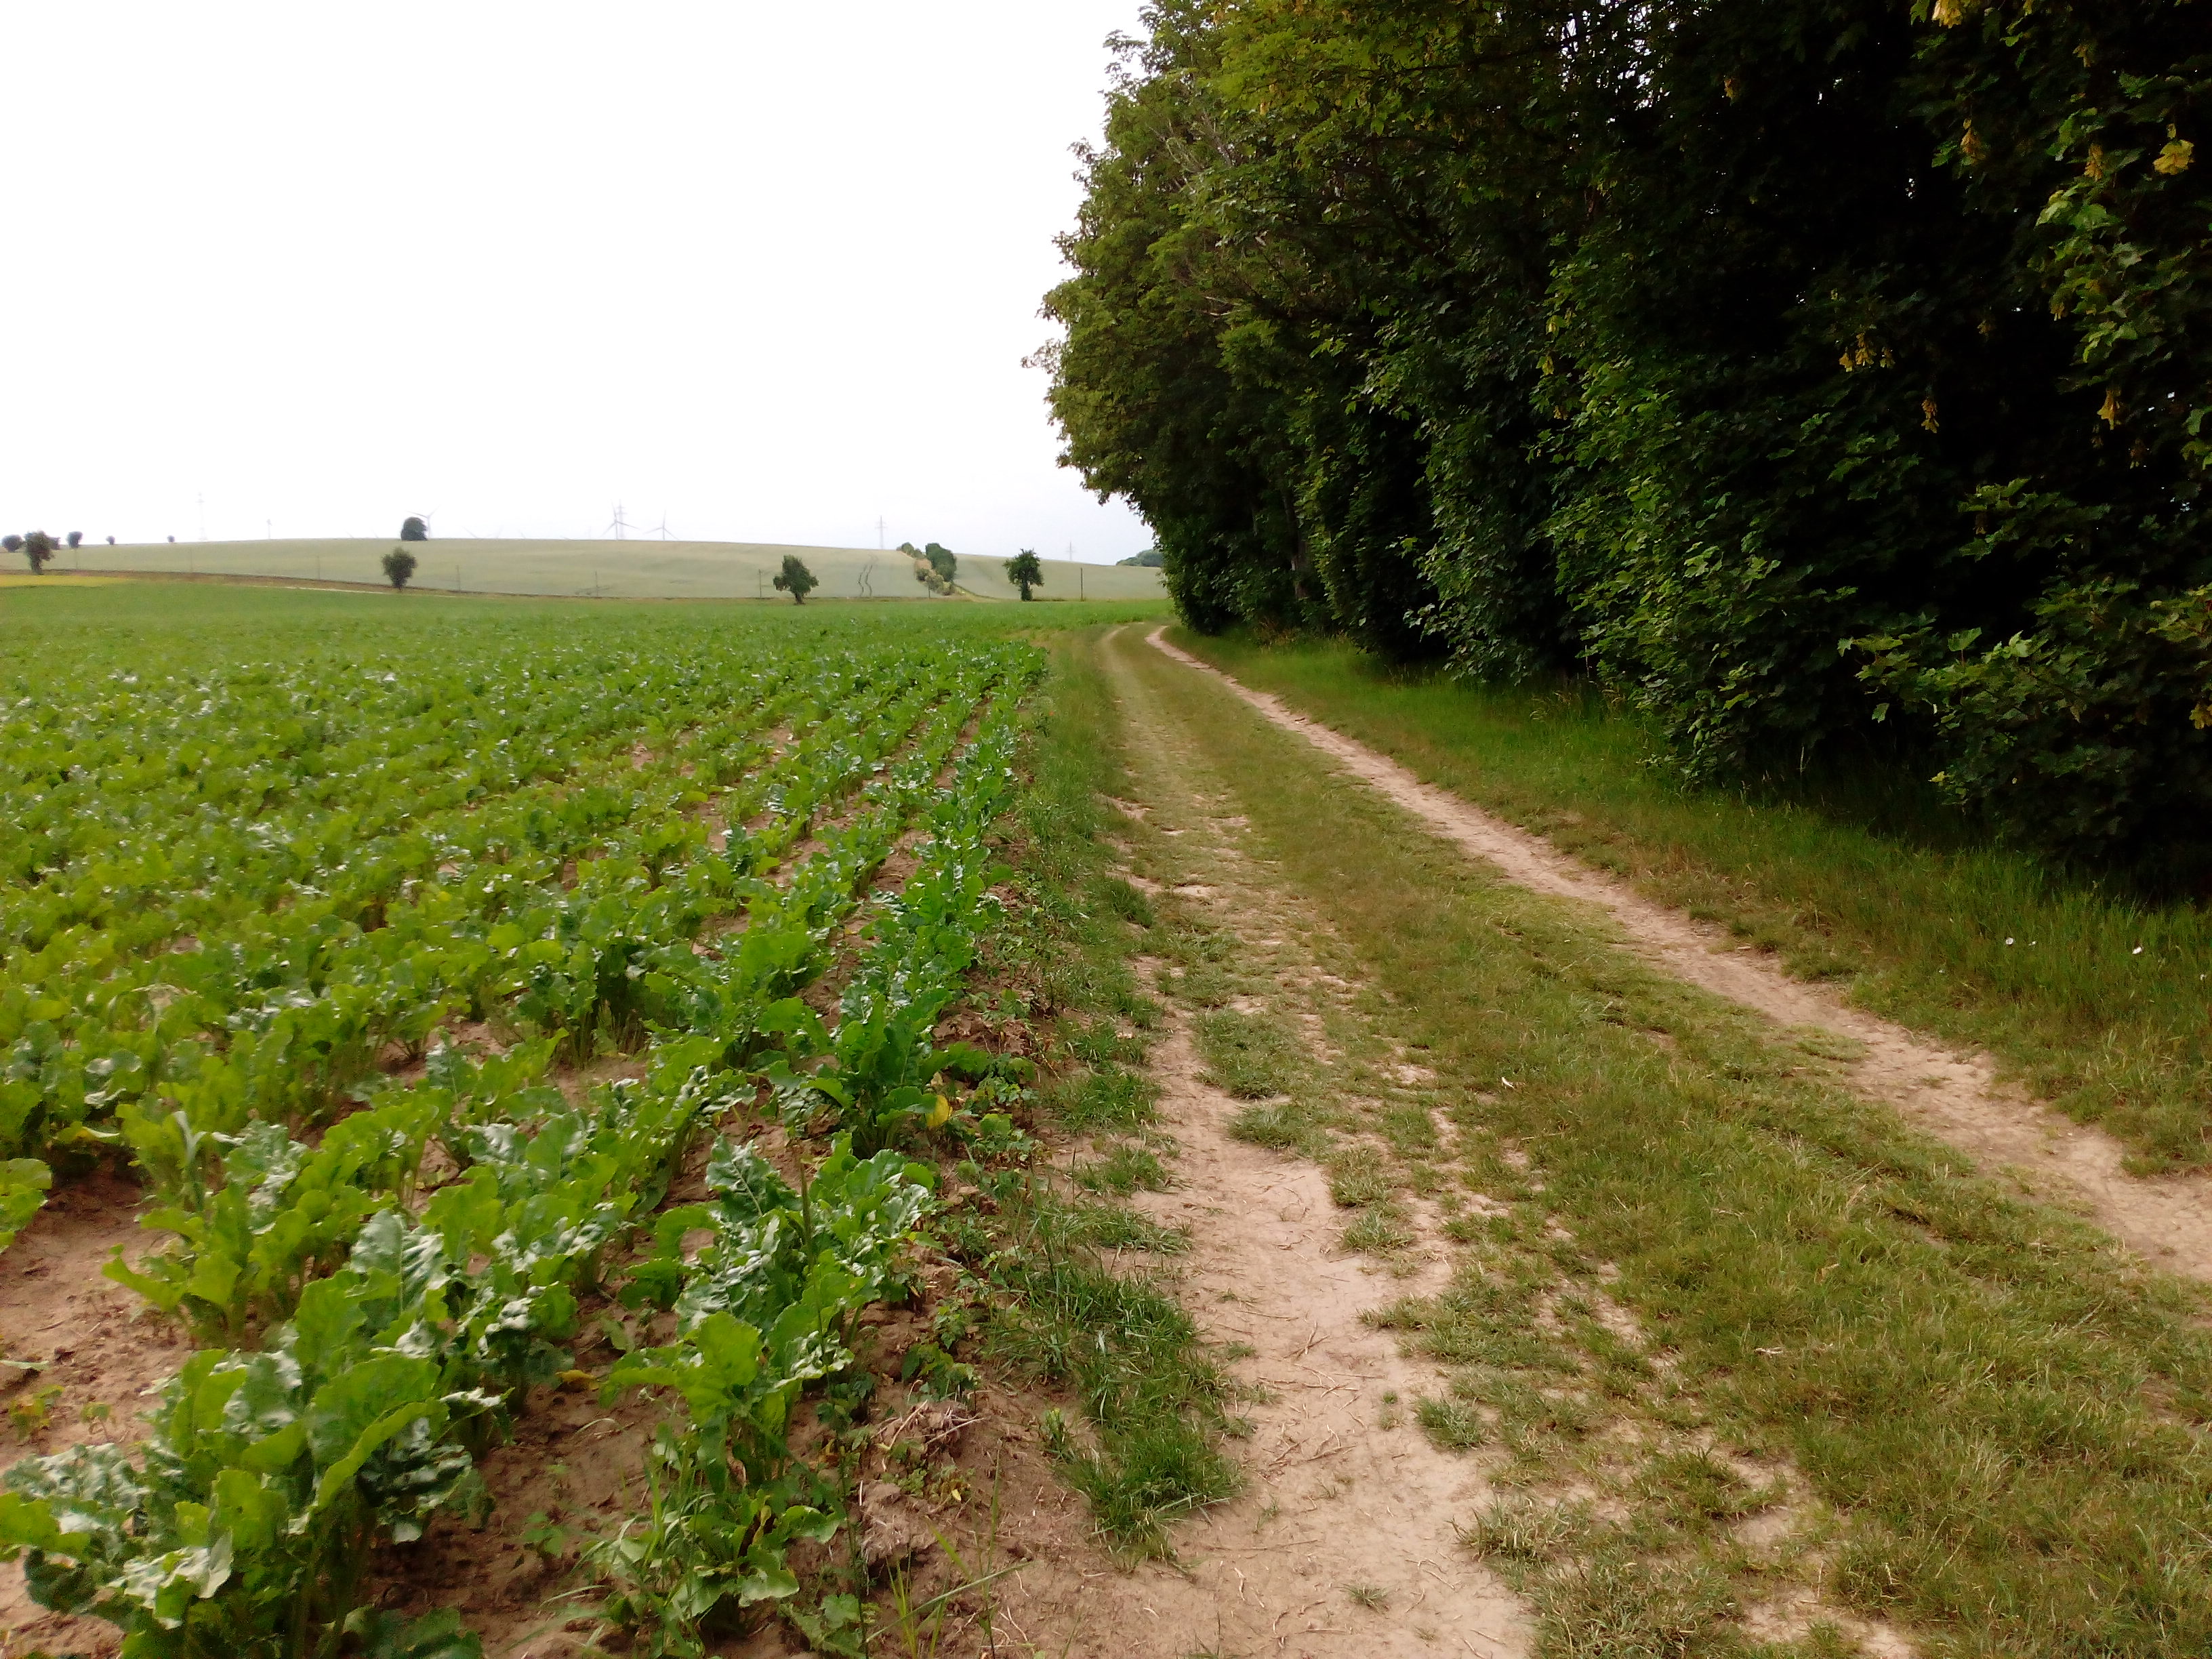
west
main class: Cropland
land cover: Sugar beet
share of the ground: > 75 %
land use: Agriculture (excluding fallow land and kitchen gardens)
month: June
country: DE
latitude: 51.2233
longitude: 10.9305
